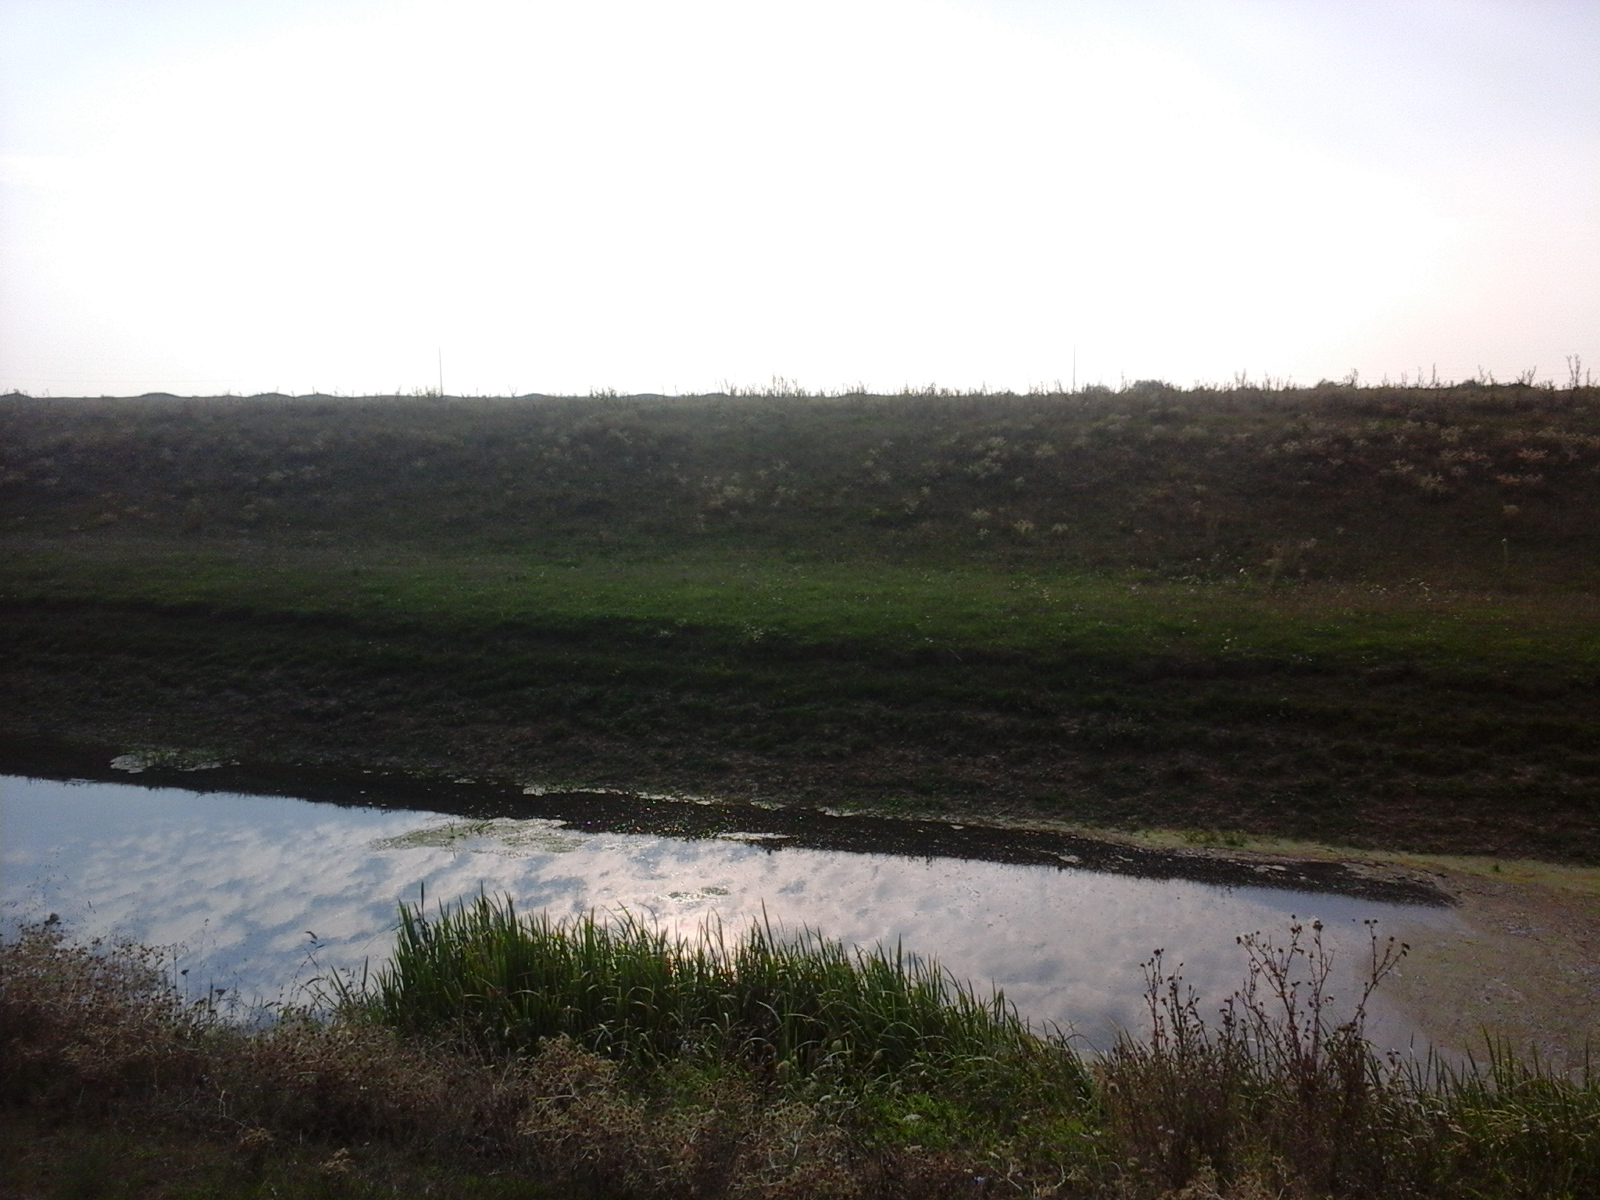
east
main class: Grassland
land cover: Grassland without tree/shrub cover
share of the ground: > 75 %
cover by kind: herbaceous plants 100 %
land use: Agriculture (excluding fallow land and kitchen gardens)
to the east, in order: Grassland without tree/shrub cover; Inland fresh running water; Grassland without tree/shrub cover
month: August
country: RO
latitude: 46.7067
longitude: 21.5365
